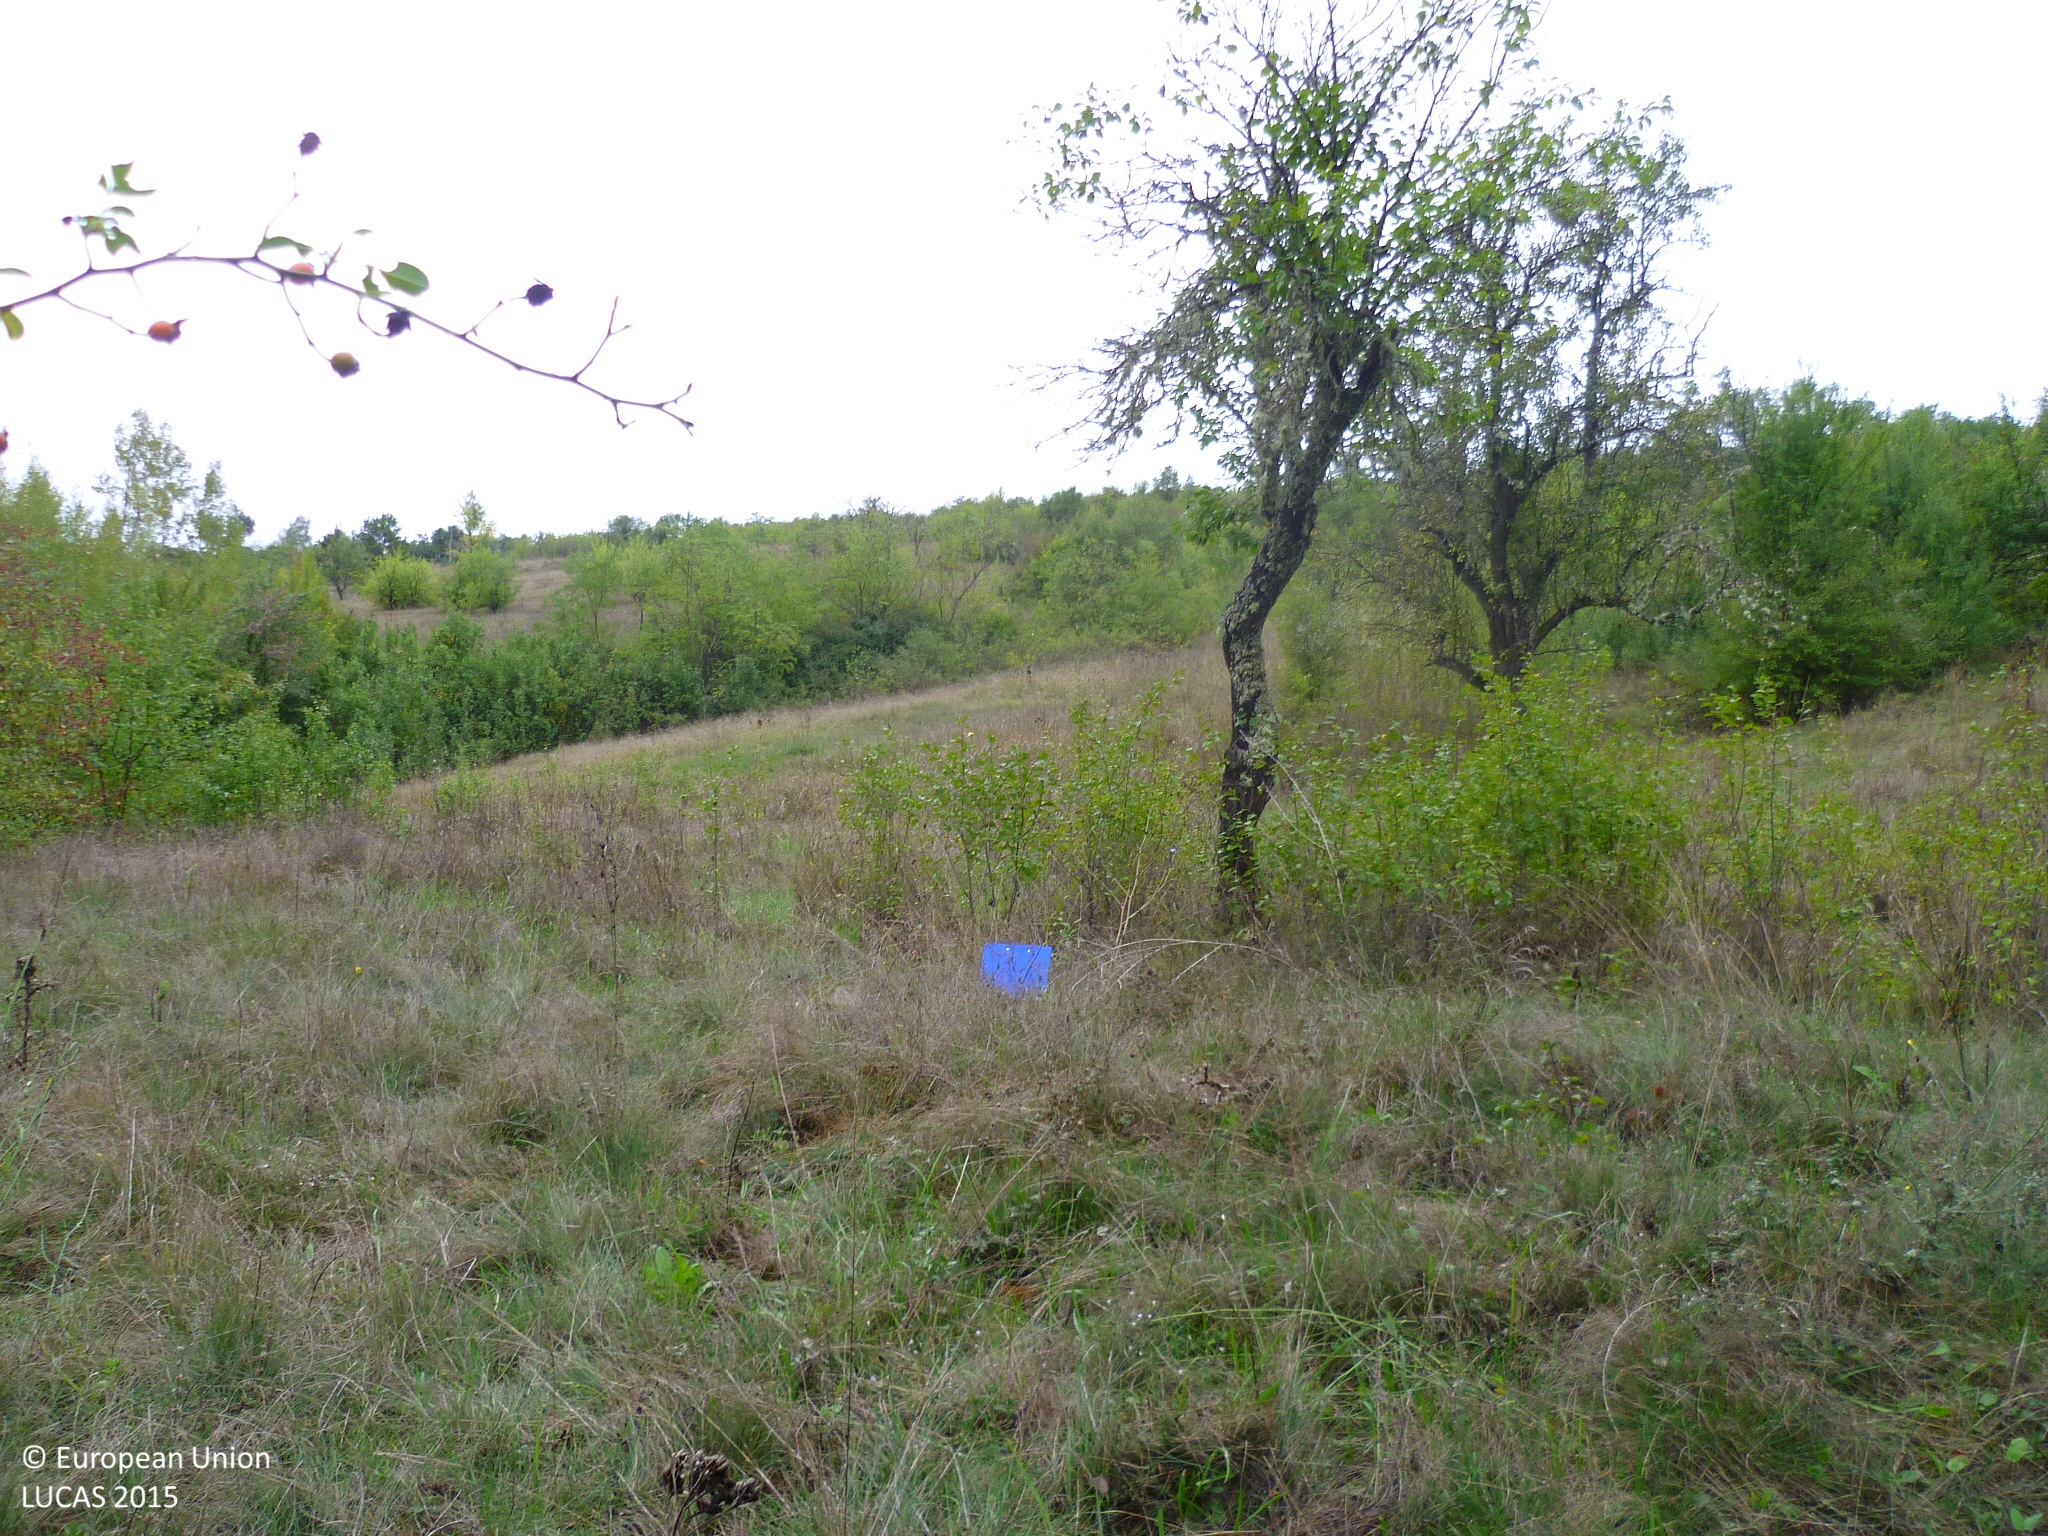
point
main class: Grassland
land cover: Grassland with sparse tree/shrub cover
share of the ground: > 75 %
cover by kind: herbaceous plants 90 %, broadleaved forest trees 5 %, shrubs 5 %
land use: Agriculture (excluding fallow land and kitchen gardens)
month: September
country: BG
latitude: 42.5833
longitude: 22.6844
